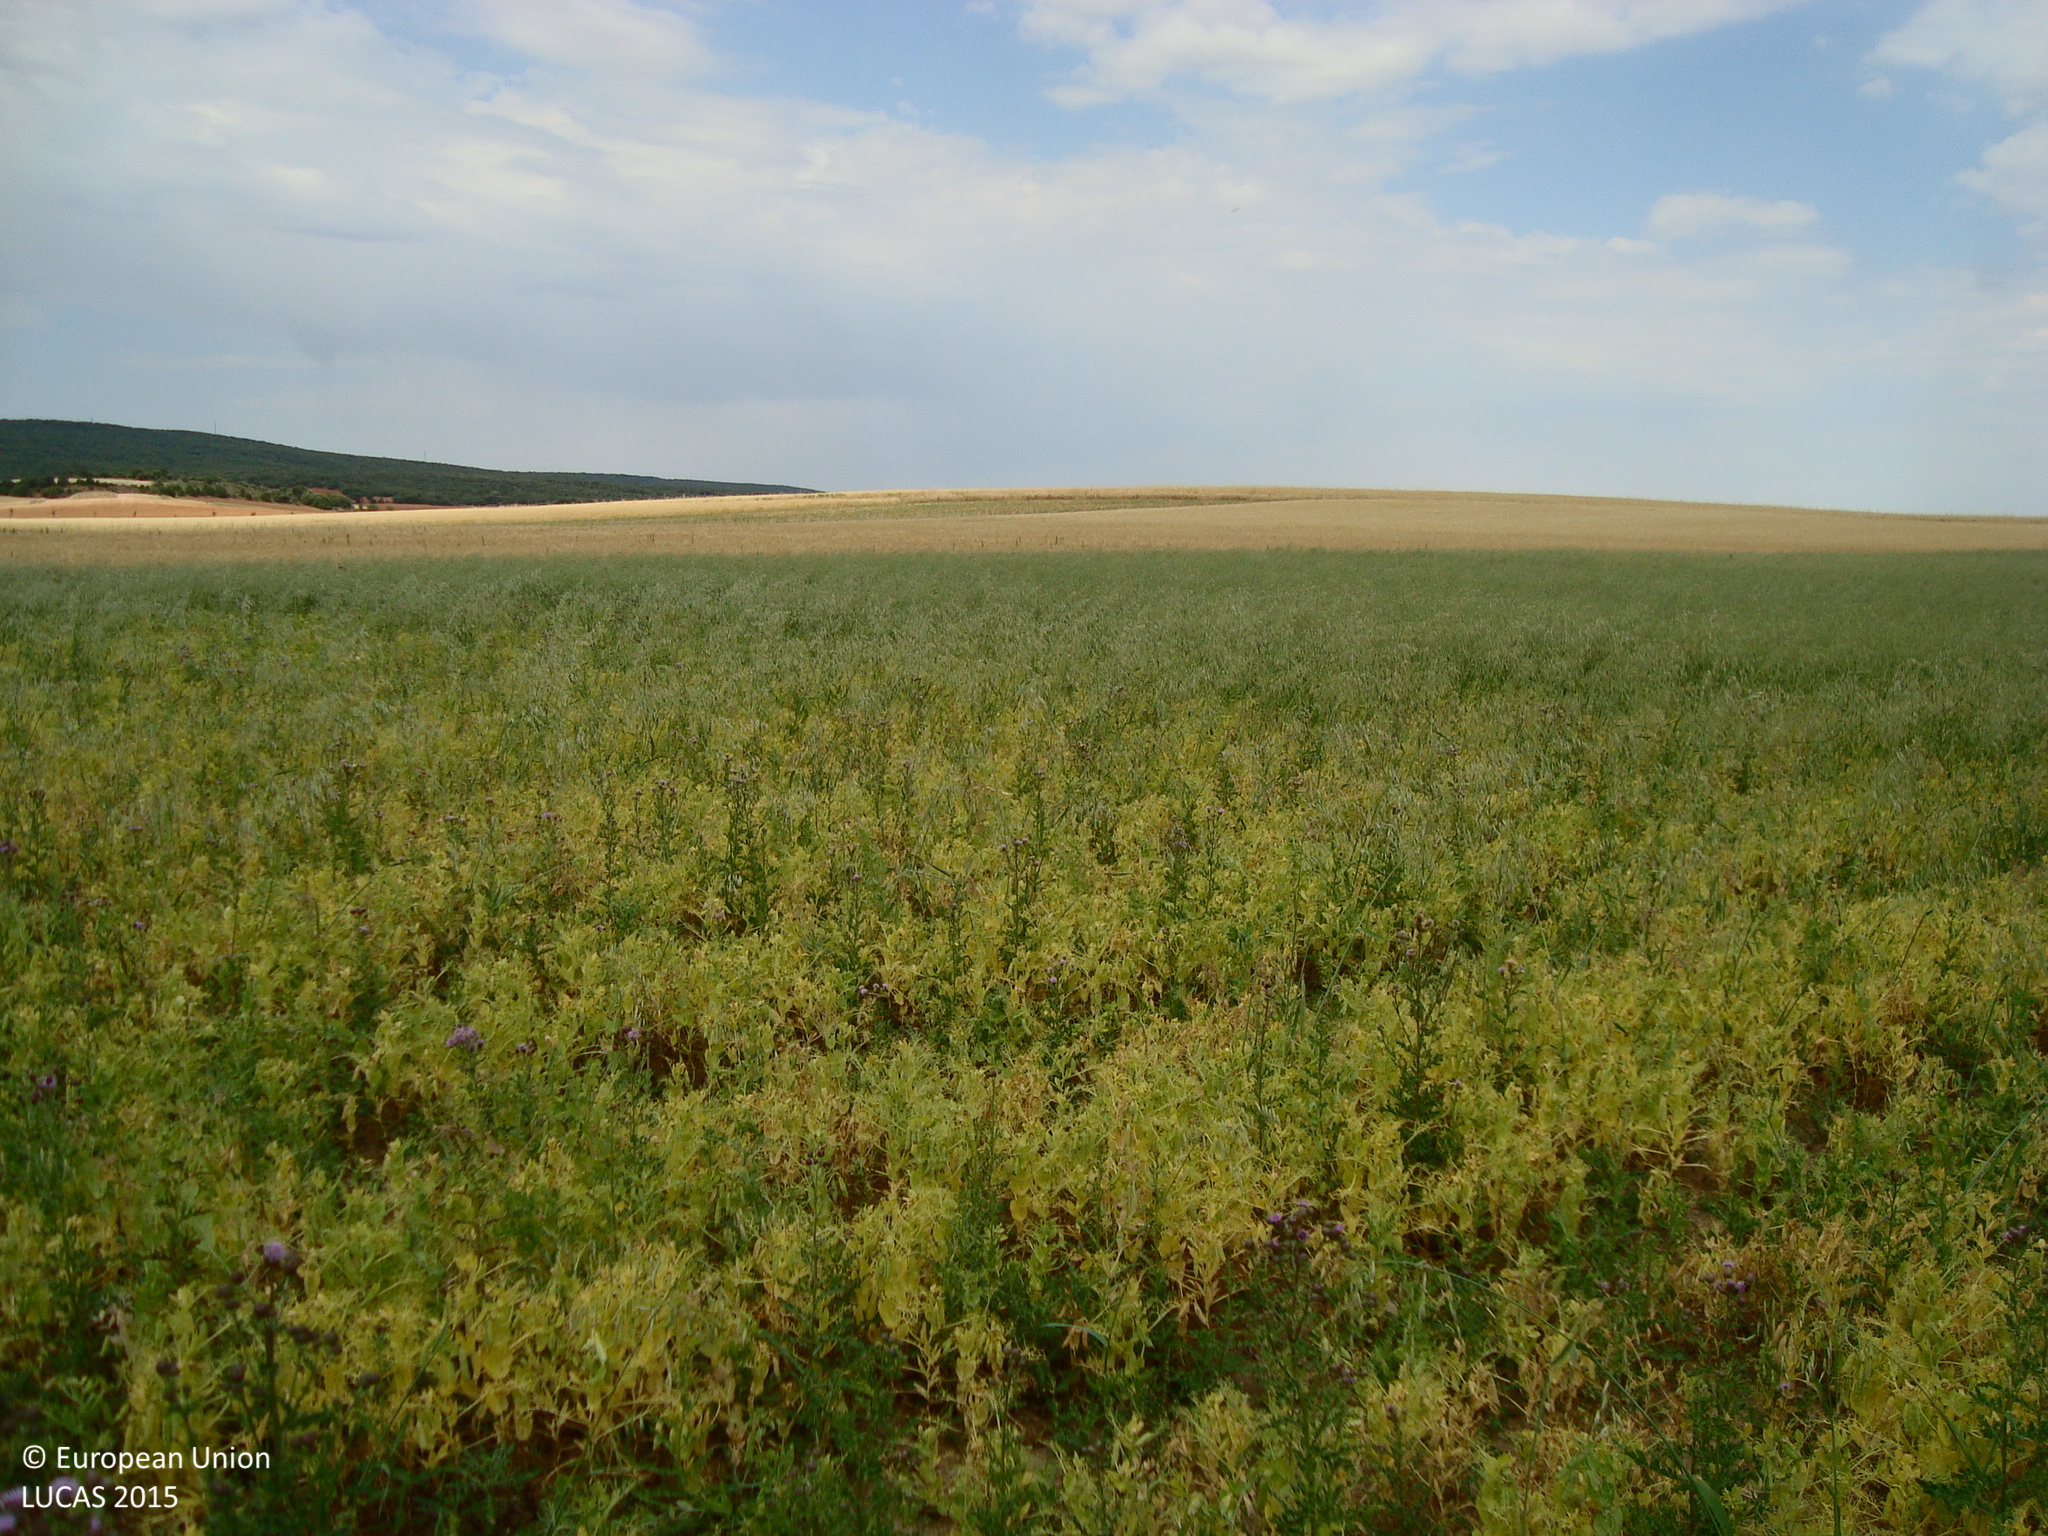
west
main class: Cropland
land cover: Dry pulses
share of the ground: > 75 %
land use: Agriculture (excluding fallow land and kitchen gardens)
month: June
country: ES
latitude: 41.9768
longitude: -3.6814
